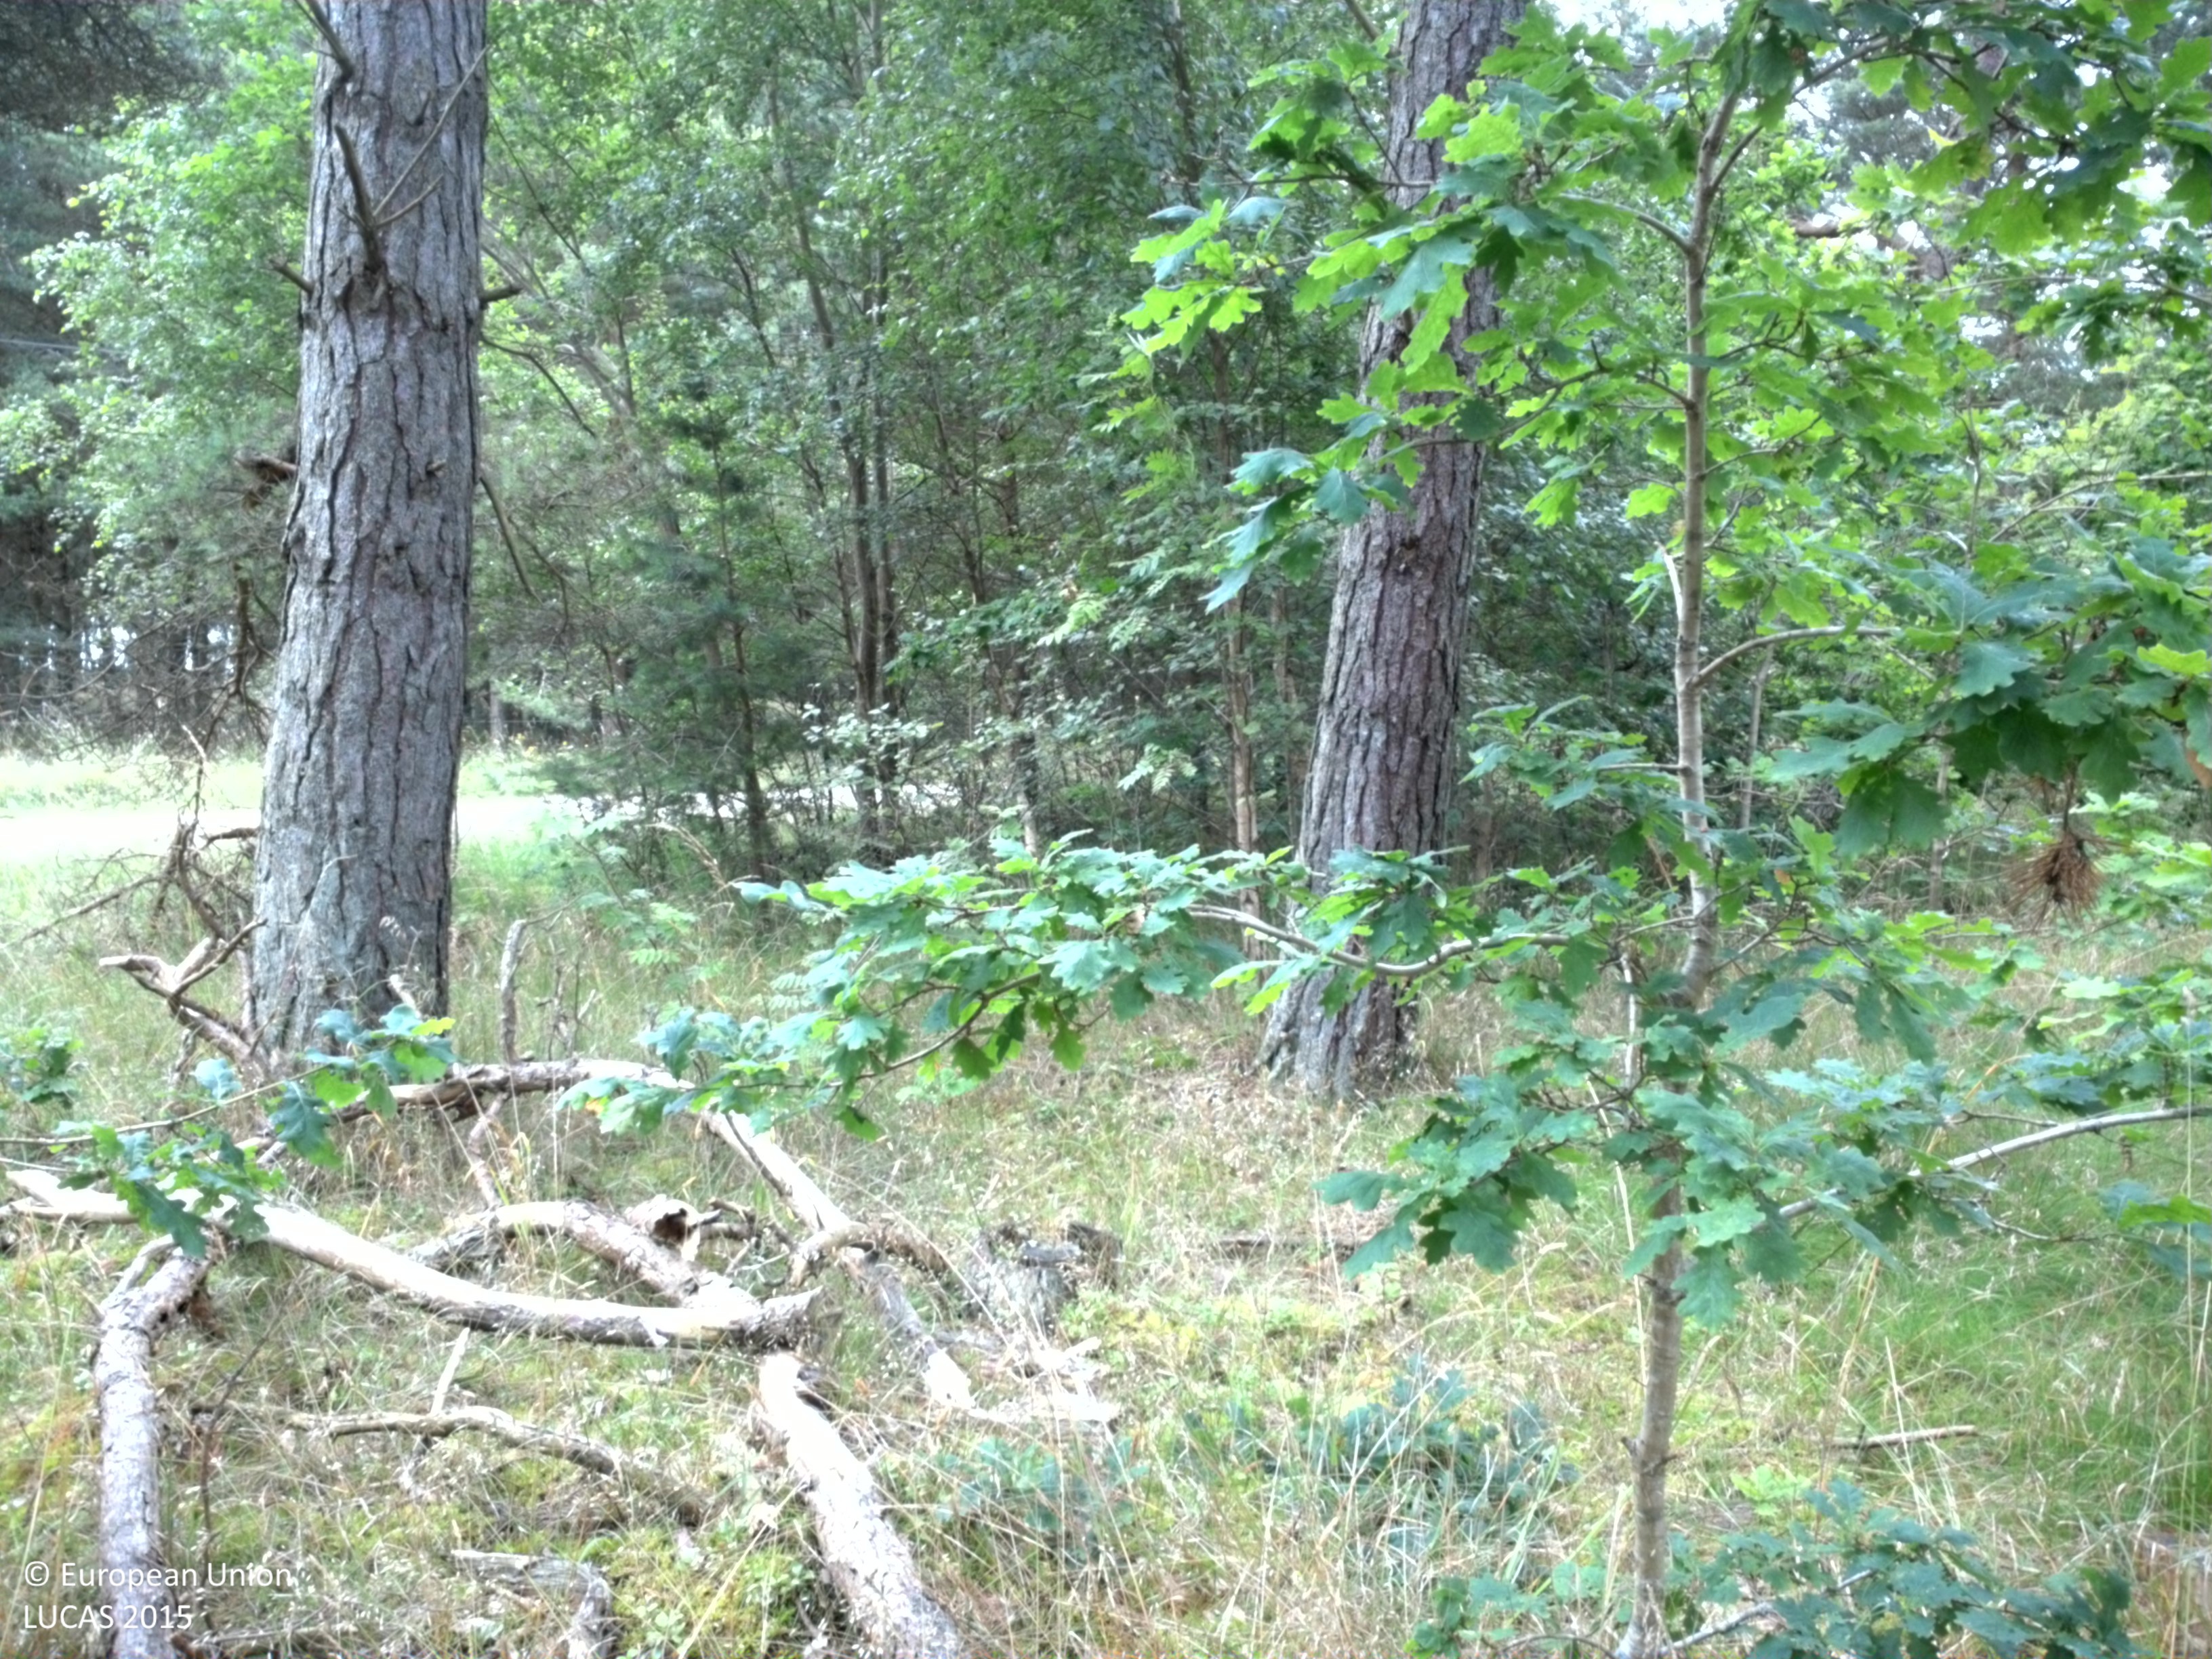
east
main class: Woodland
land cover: Pine dominated mixed woodland
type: hemiboreal forest and nemoral coniferous forest and mixed broadleaved-coniferous forest
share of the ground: > 75 %
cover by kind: coniferous forest trees 50 %, broadleaved forest trees 25 %, herbaceous plants 20 %, shrubs 5 %
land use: Forestry
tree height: > 5 m
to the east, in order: Pine dominated mixed woodland; Paved roads, cycling and walking lanes; Grass margins; Electric lines; Fences; Pine dominated coniferous woodland; Electric lines; Pine dominated coniferous woodland; Electric lines; Inland marshes; Fences; Inland marshes; Fences; Grassland without tree/shrub cover
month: July
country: SE
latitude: 57.2328
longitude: 18.6749
